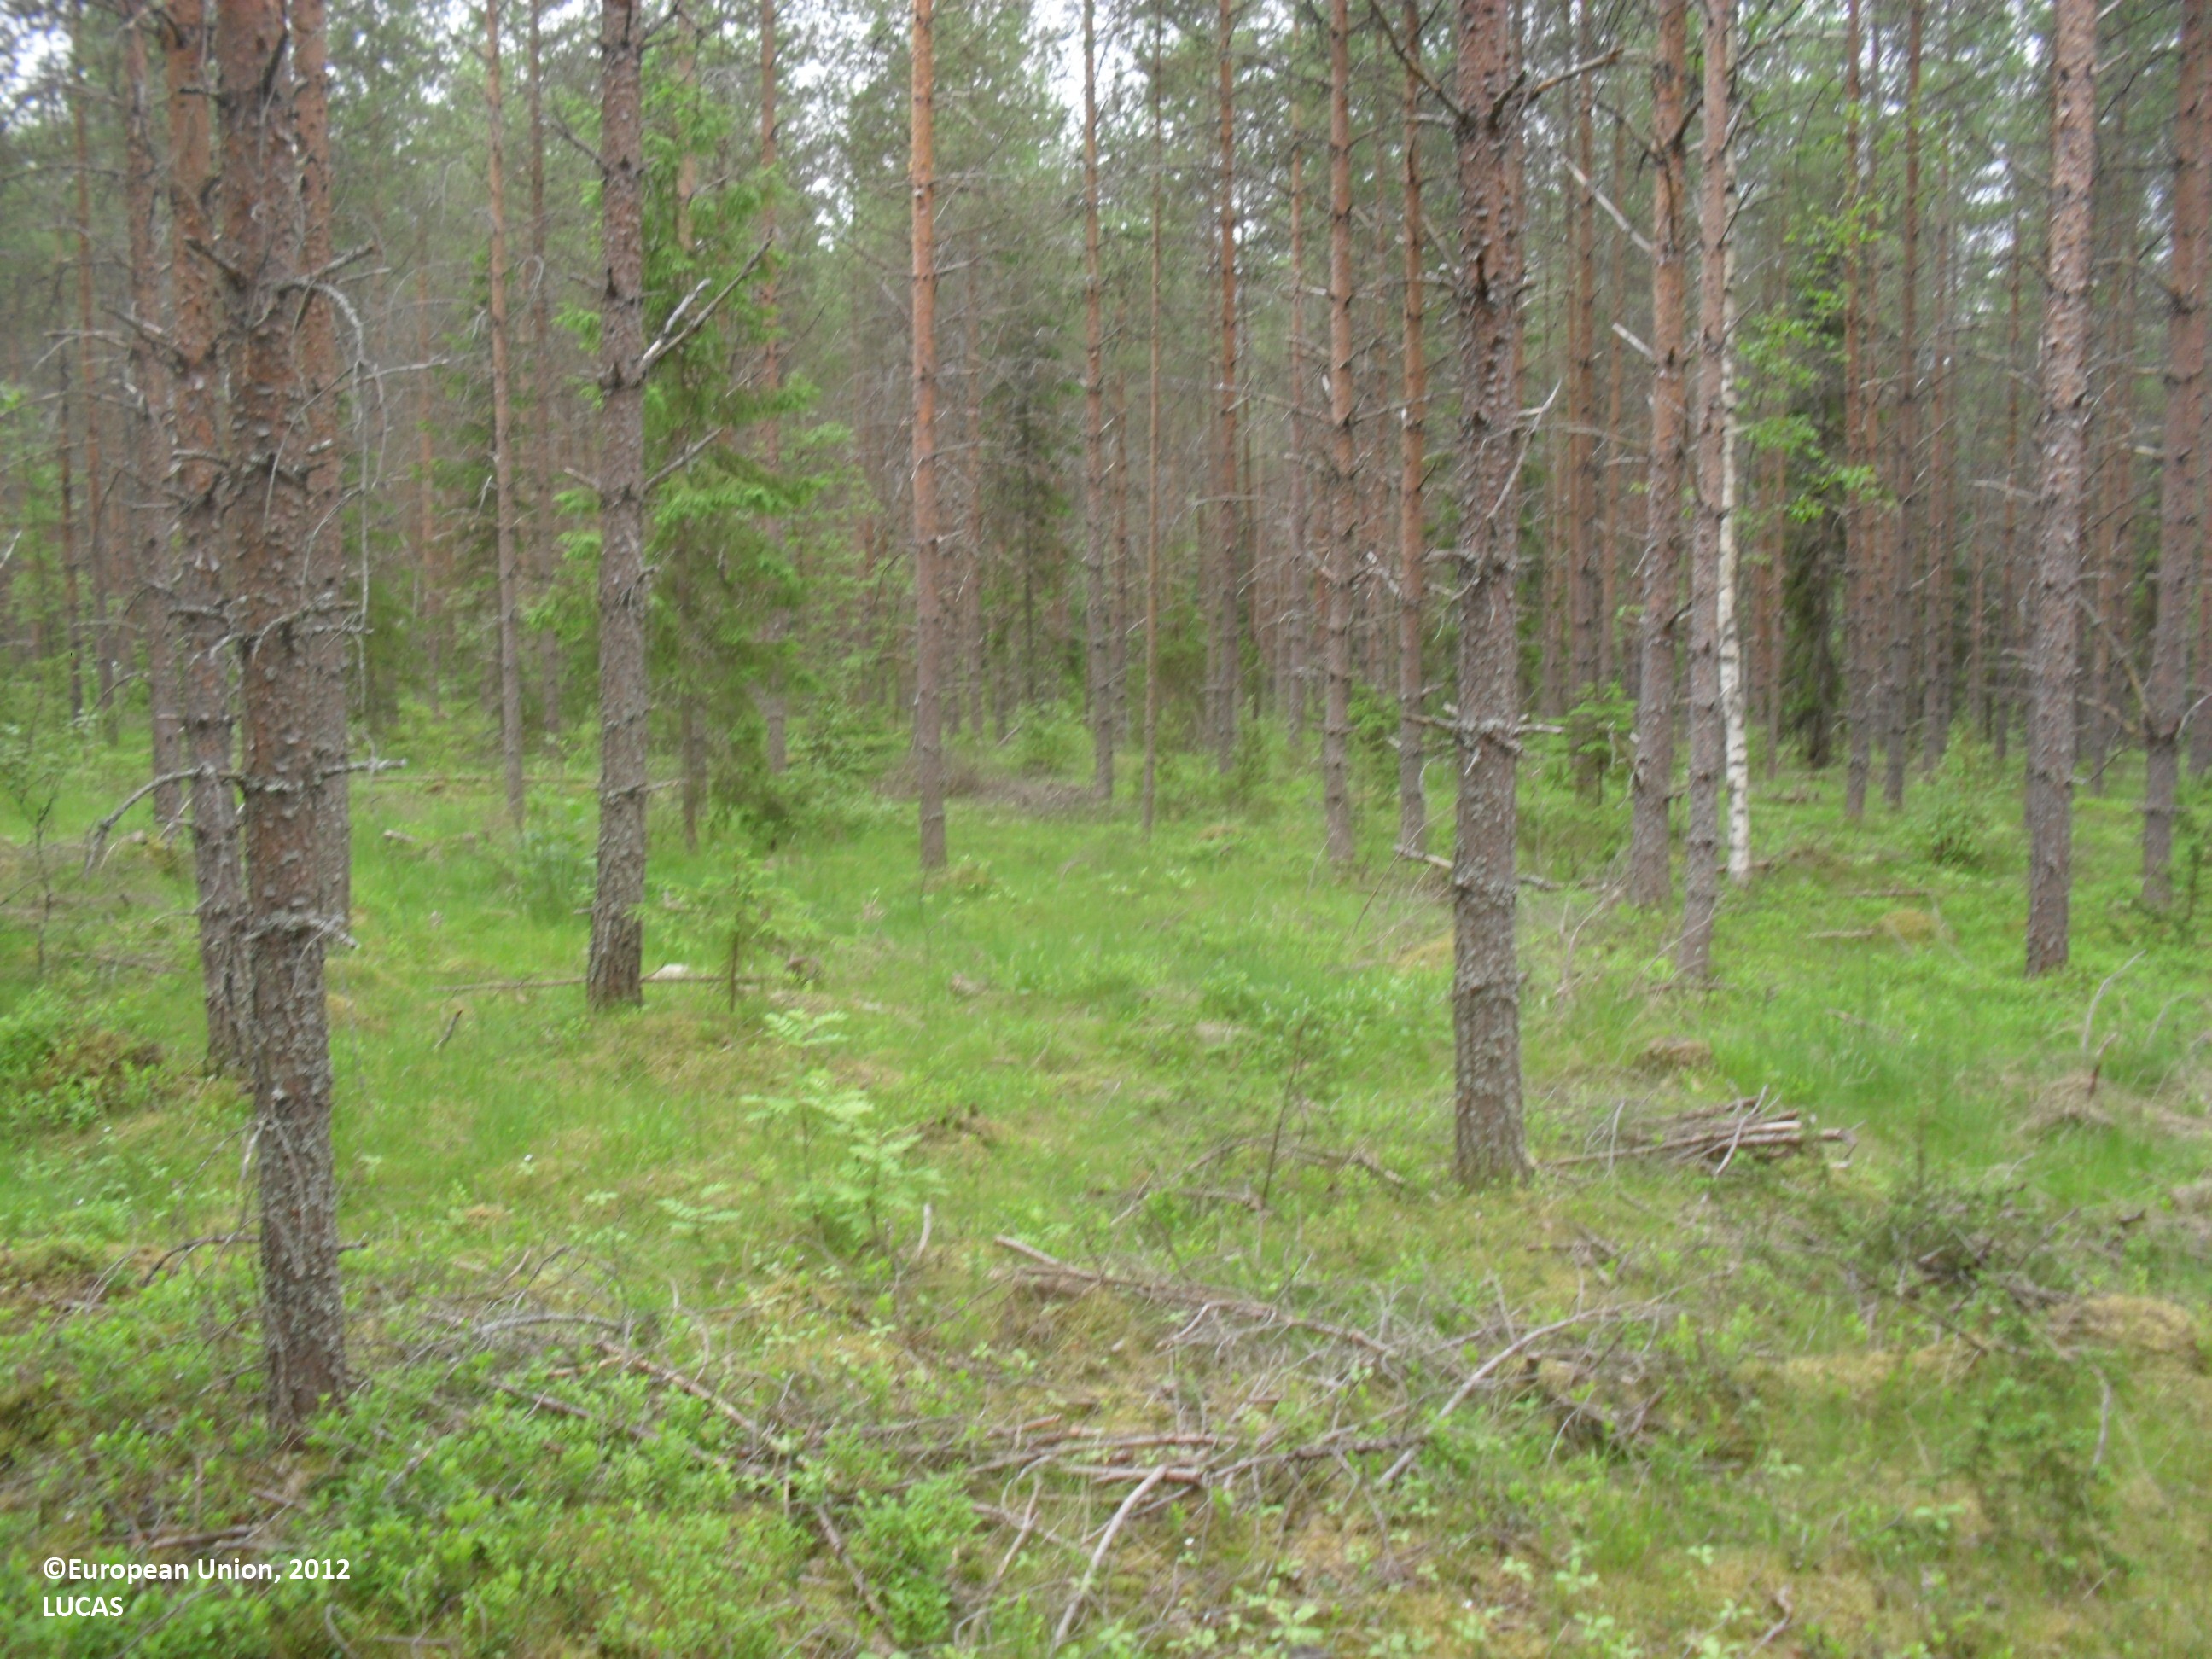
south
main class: Woodland
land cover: Pine dominated coniferous woodland
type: boreal forest
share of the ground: 25 - 50 %
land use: Forestry
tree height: > 5 m
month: June
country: FI
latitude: 63.4941
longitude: 23.2122
